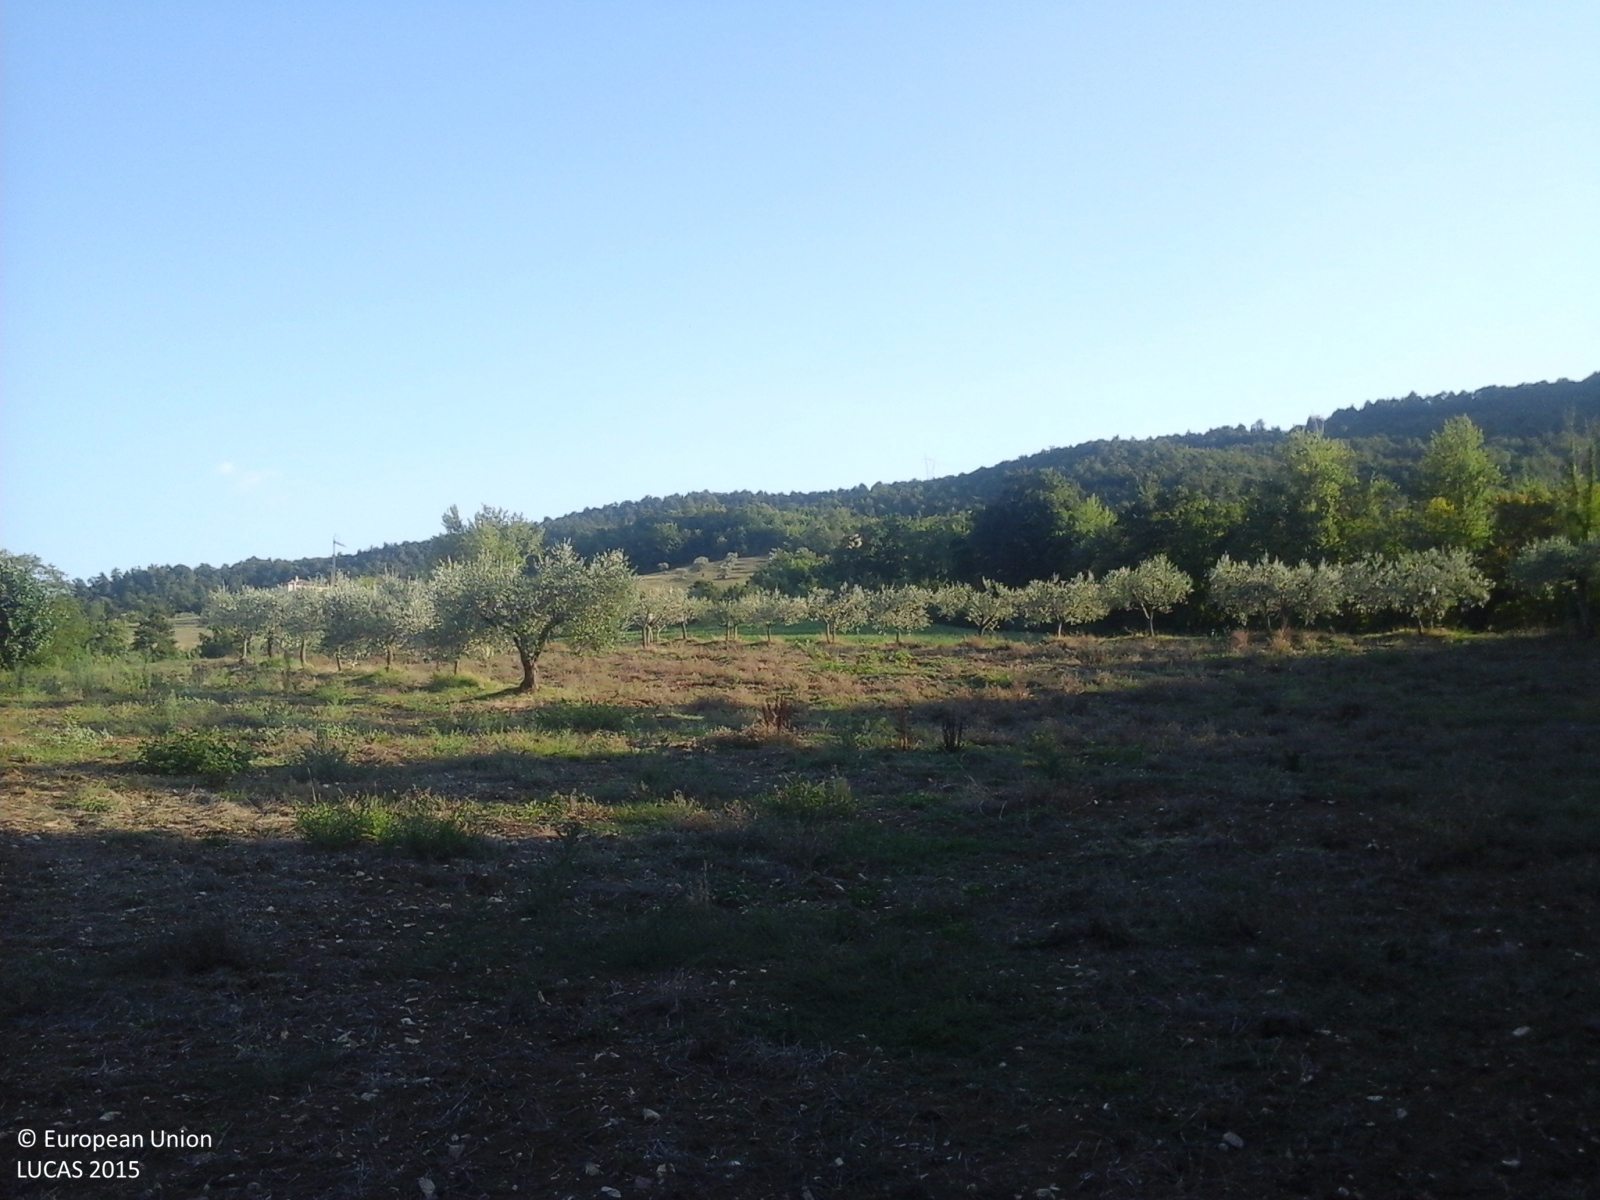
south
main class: Woodland
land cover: Broadleaved woodland
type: thermophilous deciduous forest
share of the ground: > 75 %
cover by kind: broadleaved forest trees 70 %, shrubs 20 %, herbaceous plants 10 %
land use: Forestry
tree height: > 5 m
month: August
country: IT
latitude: 42.8254
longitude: 12.3535
